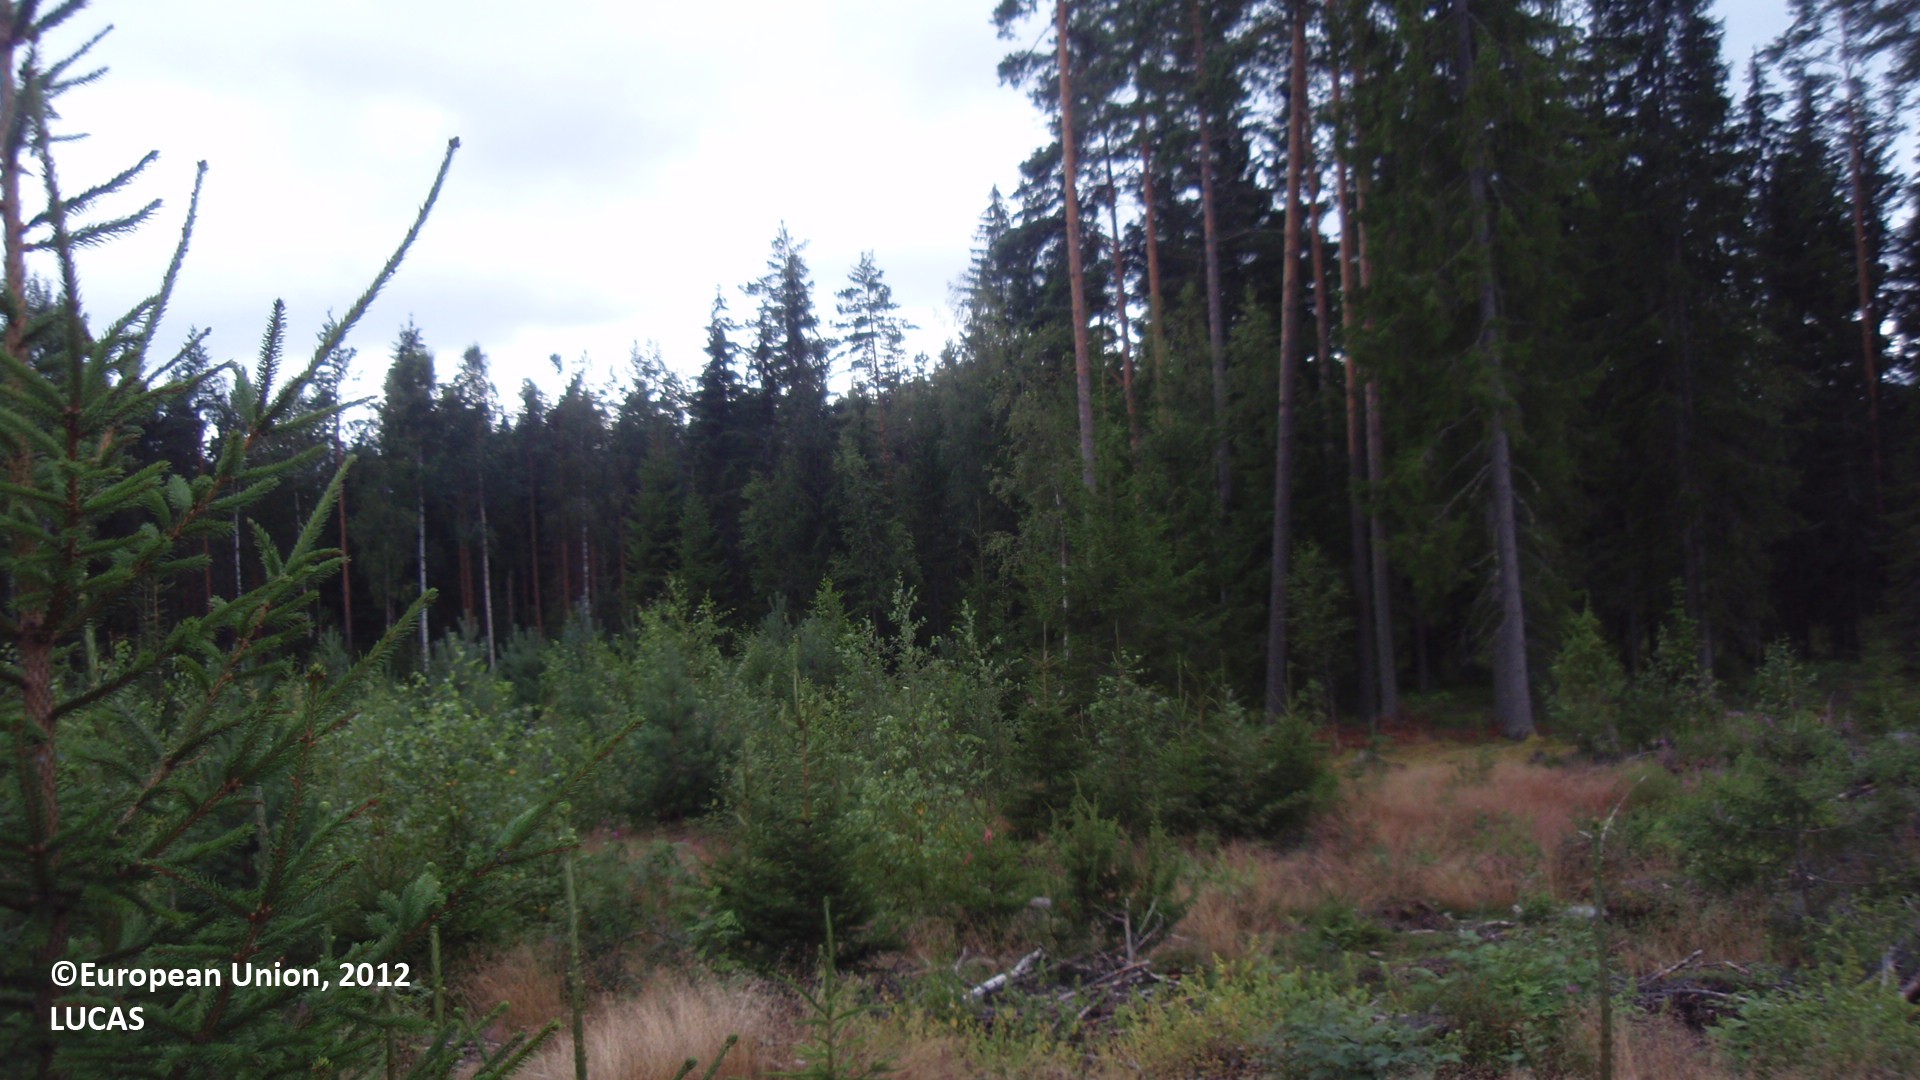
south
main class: Woodland
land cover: Other coniferous woodland
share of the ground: 10 - 25 %
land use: Forestry
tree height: < 5 m
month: August
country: FI
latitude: 61.0632
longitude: 27.5818
